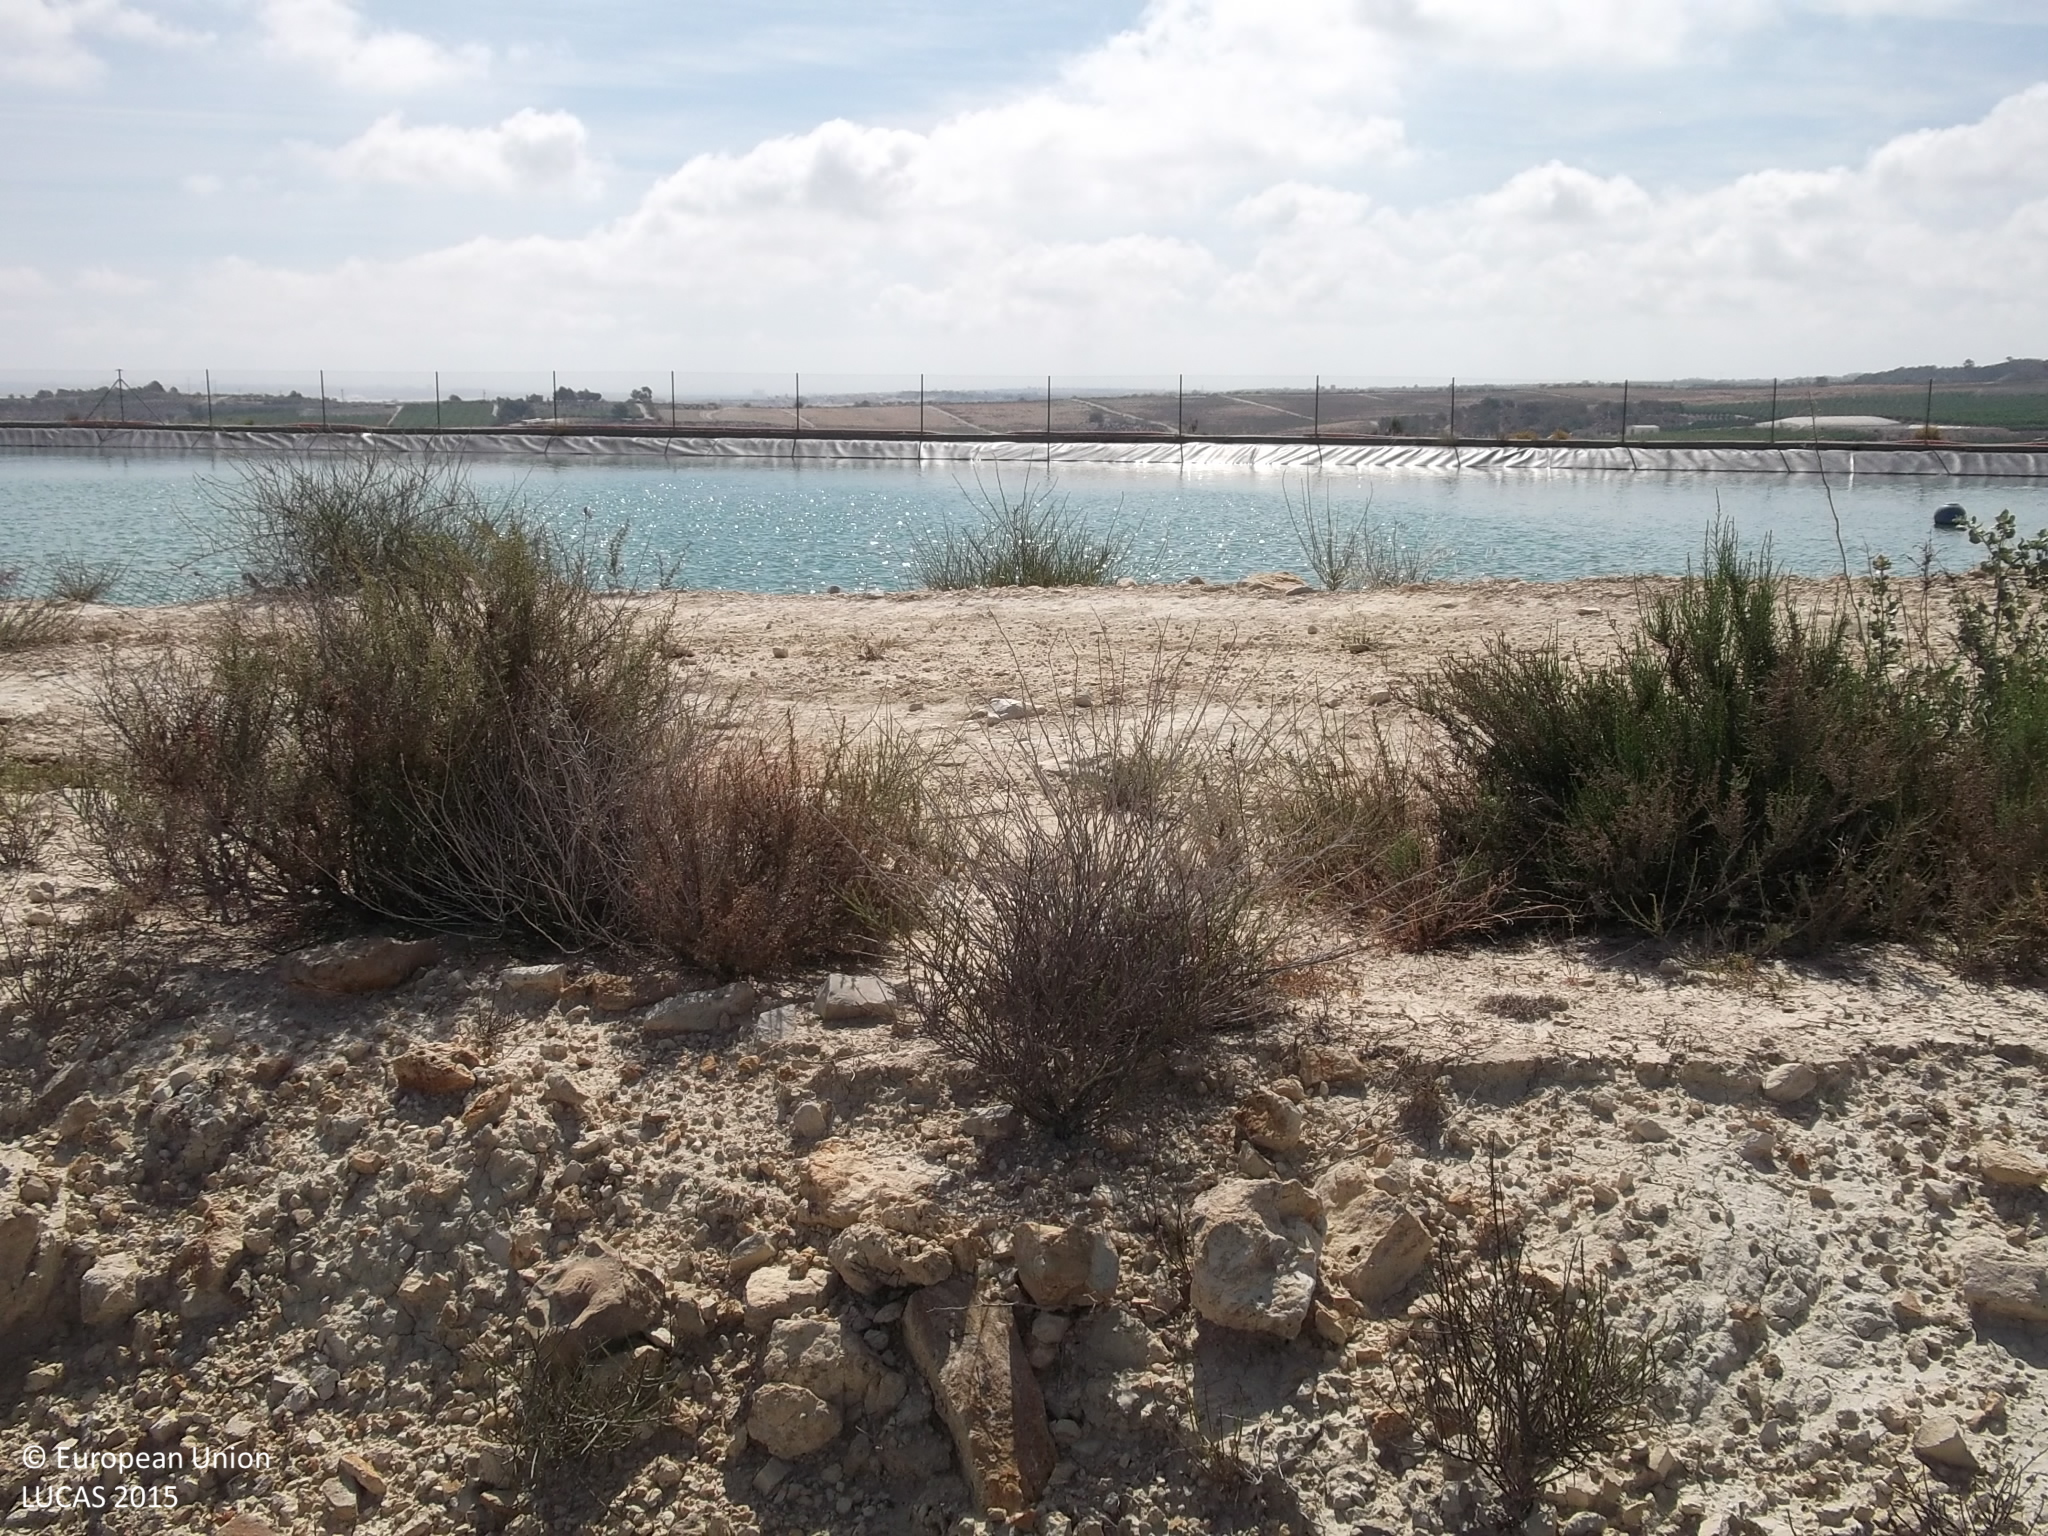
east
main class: Shrubland
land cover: Shrubland without tree cover
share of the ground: 25 - 50 %
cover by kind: shrubs 40 %, herbaceous plants 30 %, consolidated bare surface 30 %
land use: Semi-natural and natural areas not in use
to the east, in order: Shrubland without tree cover; Tracks; Fences; Inland fresh water bodies; Fences; Spontaneously vegetated surfaces; Paved roads, cycling and walking lanes; Other citrus fruit; Tracks; Other citrus fruit
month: May
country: ES
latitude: 37.9859
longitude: -0.8332
